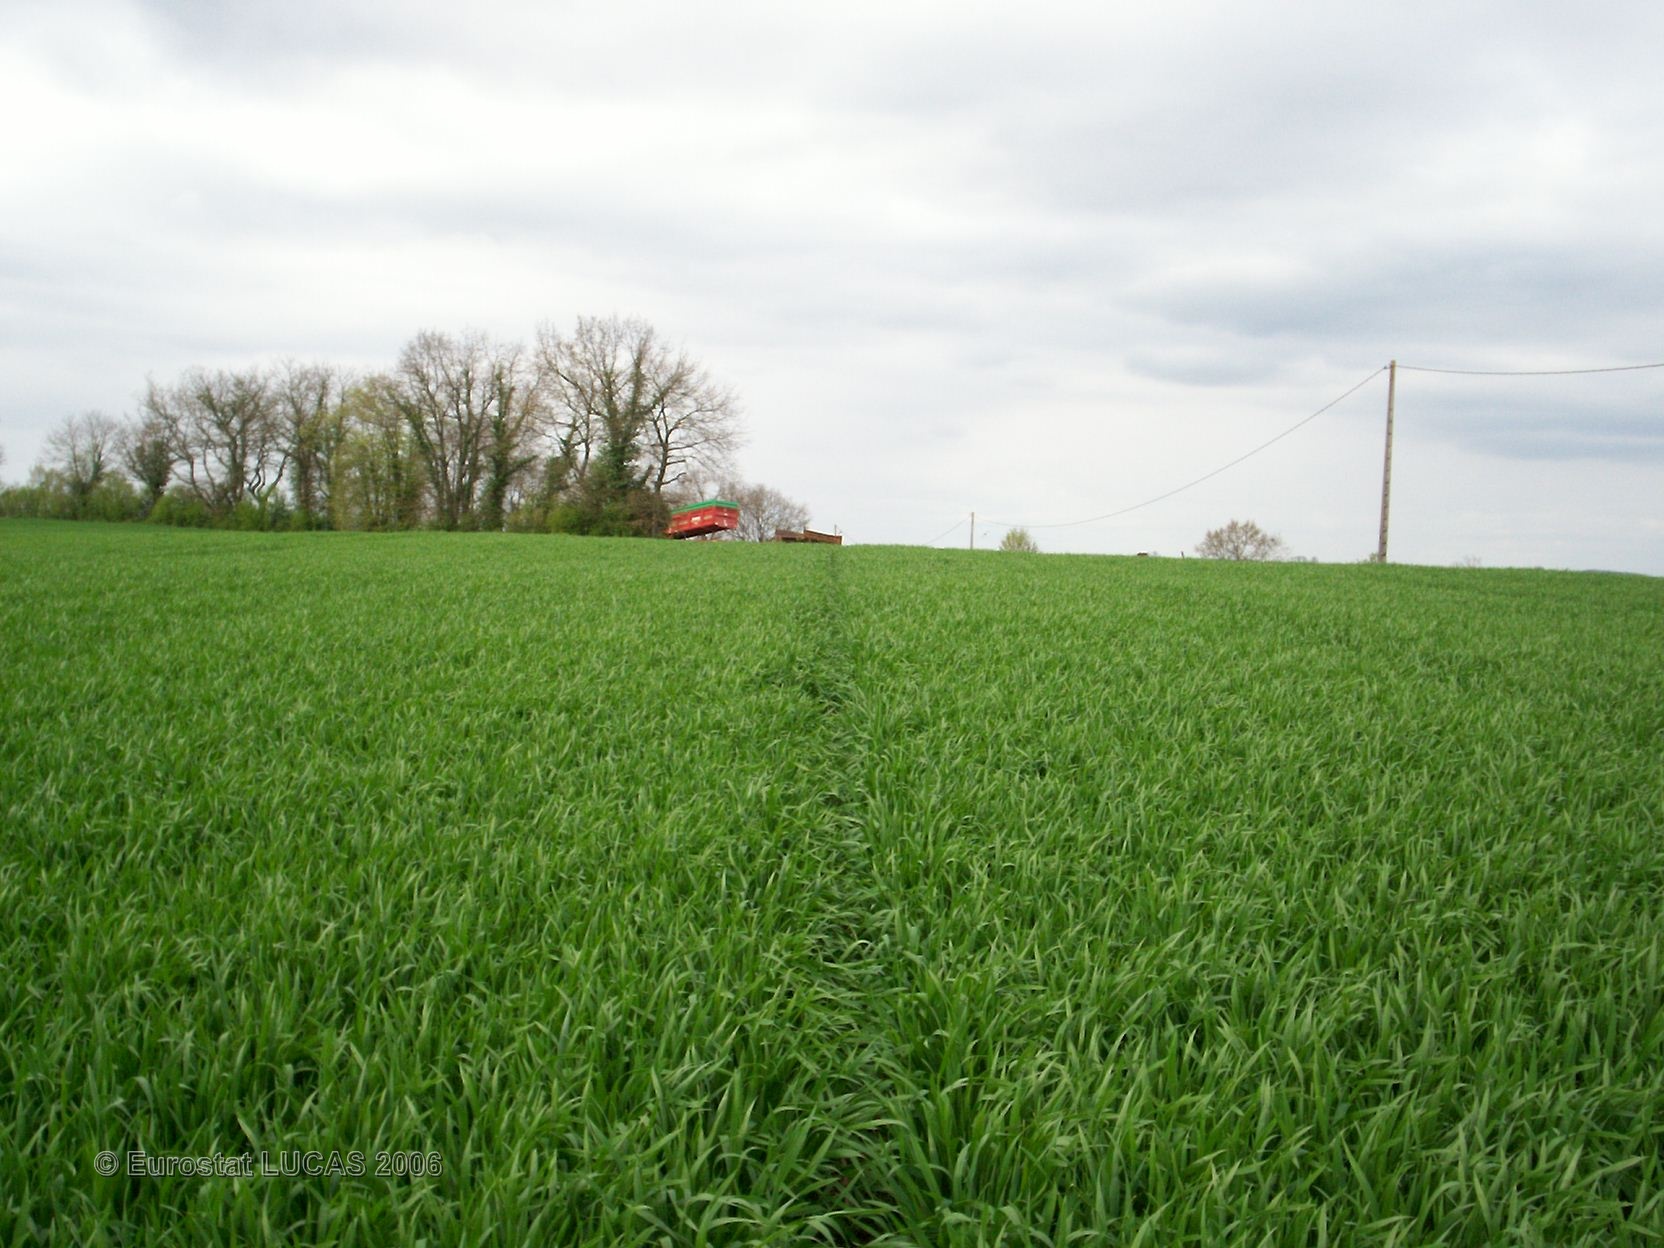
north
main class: Cropland
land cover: Common wheat
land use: Agriculture (excluding fallow land and kitchen gardens)
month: April
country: FR
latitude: 43.6842
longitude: 0.1822
